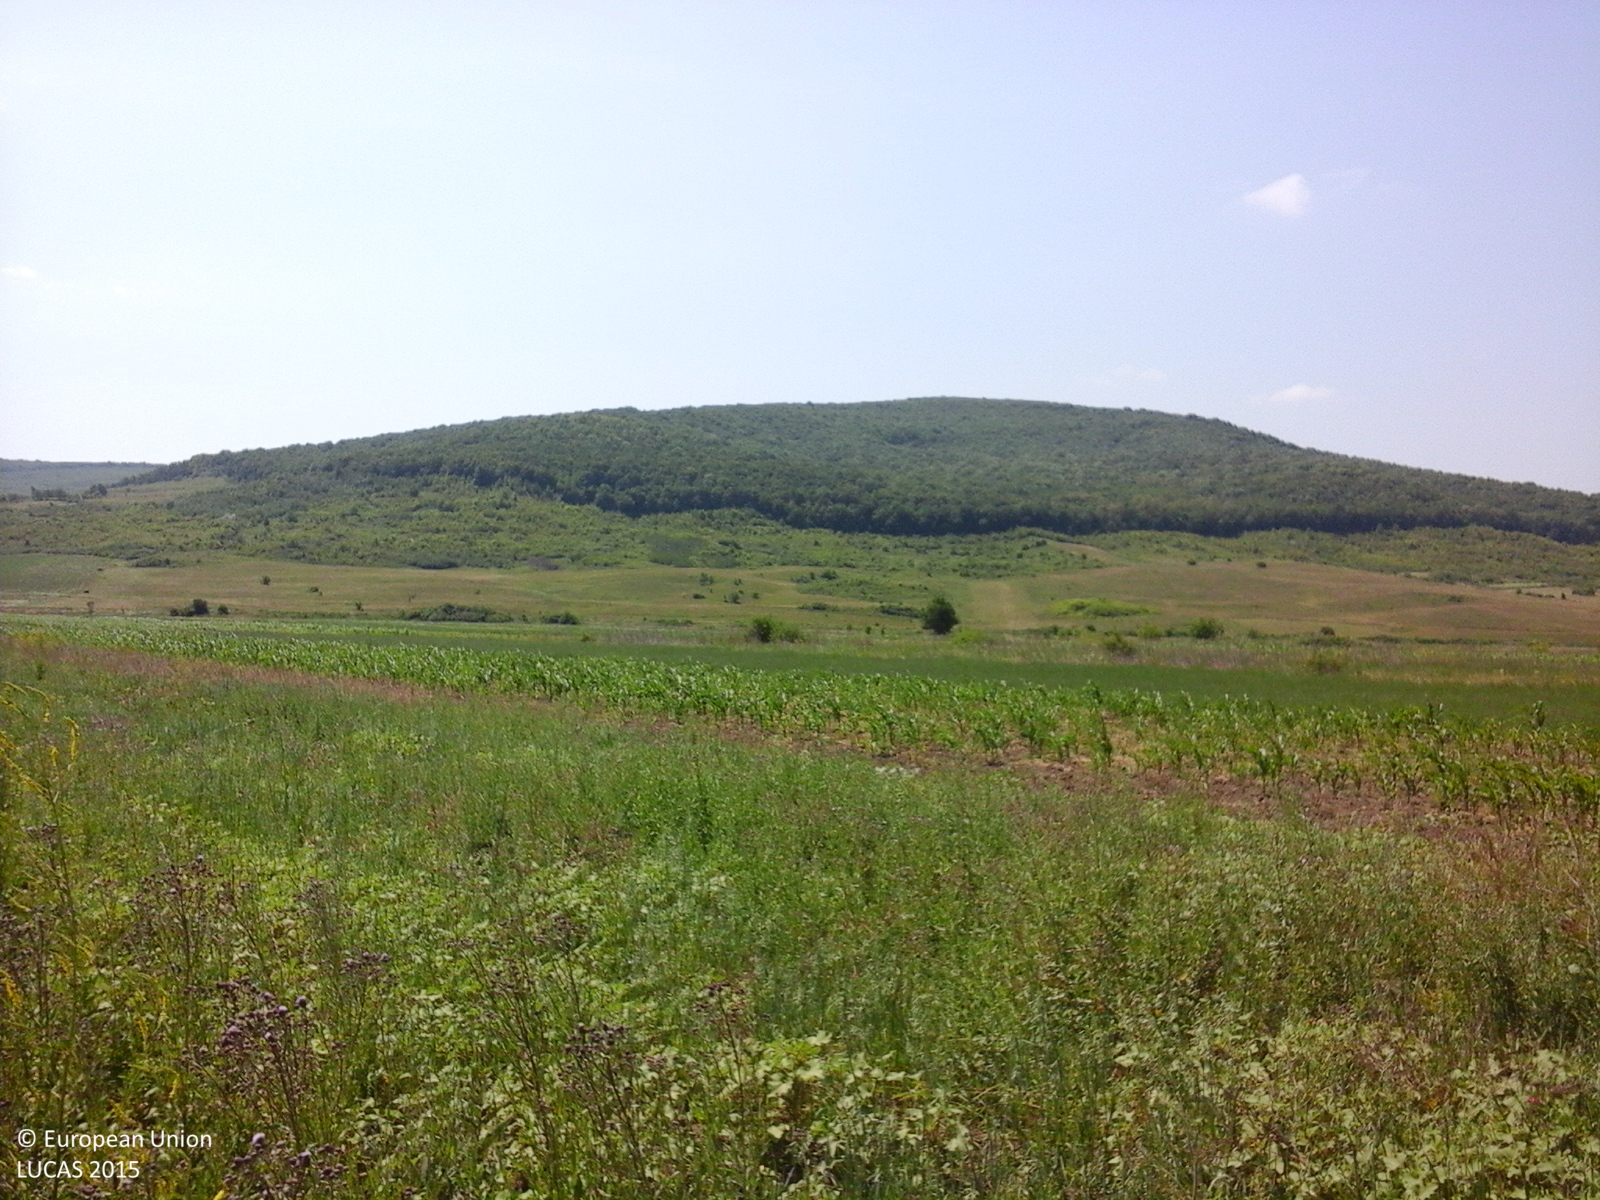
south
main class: Cropland
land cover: Lucerne
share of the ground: > 75 %
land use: Agriculture (excluding fallow land and kitchen gardens)
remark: Harvested field
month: June
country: RO
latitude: 46.8420
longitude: 27.2979
